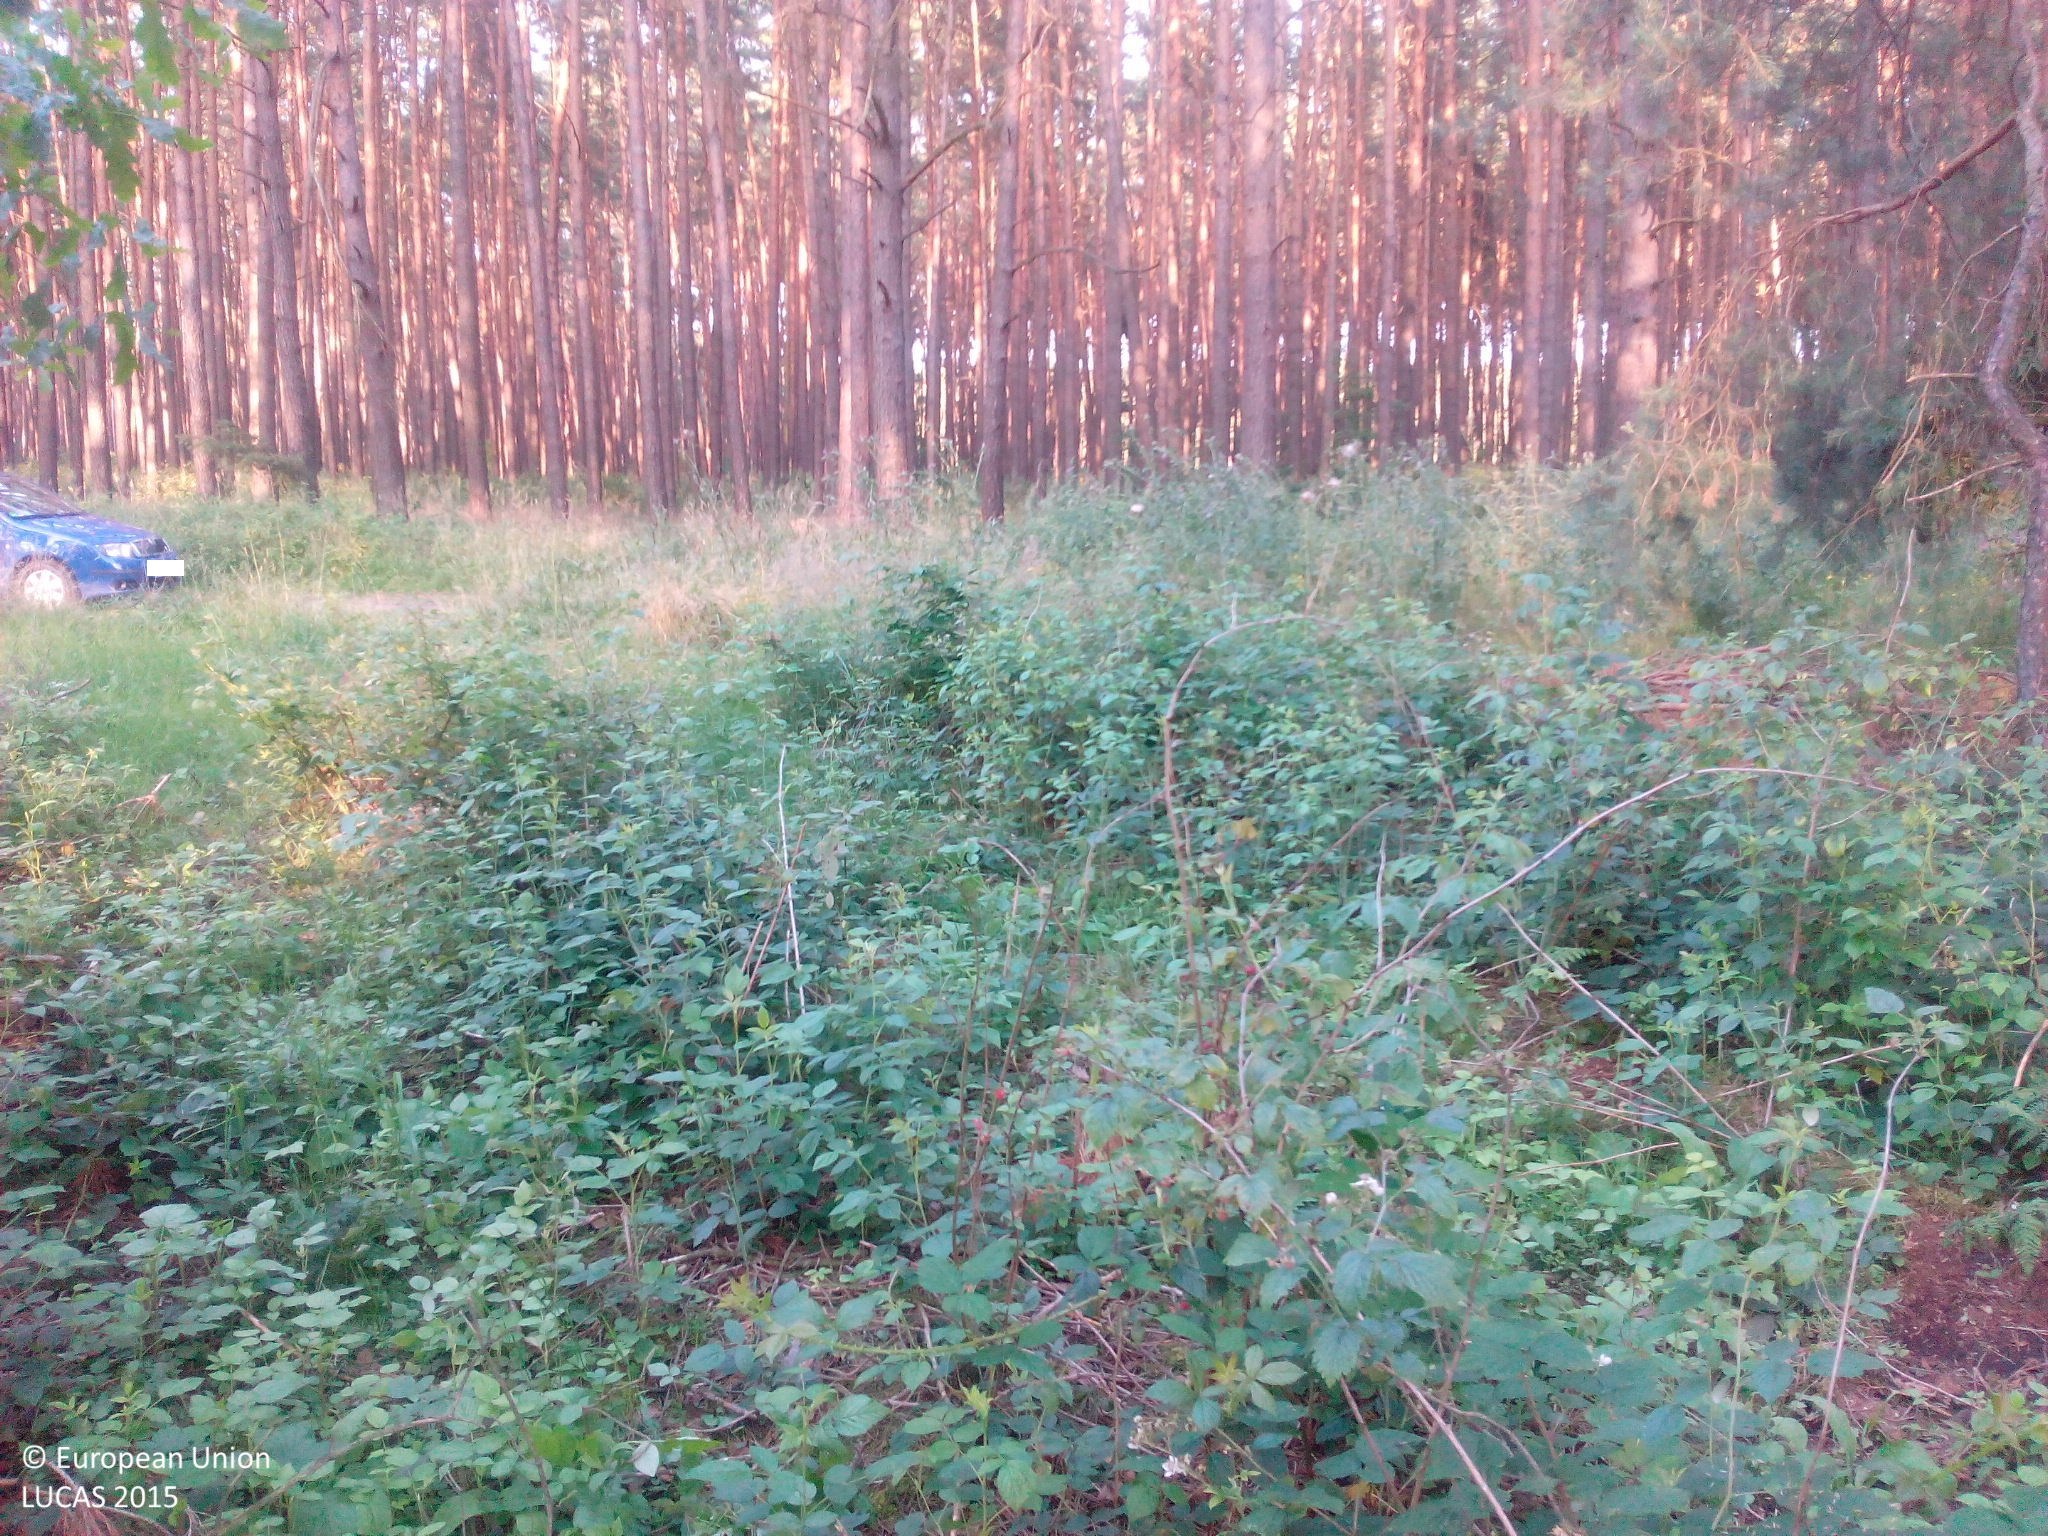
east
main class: Woodland
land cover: Pine dominated coniferous woodland
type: hemiboreal forest and nemoral coniferous forest and mixed broadleaved-coniferous forest
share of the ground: > 75 %
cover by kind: coniferous forest trees 90 %, shrubs 10 %
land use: Forestry
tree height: > 5 m
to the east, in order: Pine dominated coniferous woodland; Grassland without tree/shrub cover; Tracks; Pine dominated coniferous woodland
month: July
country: DE
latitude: 51.9941
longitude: 12.3736
